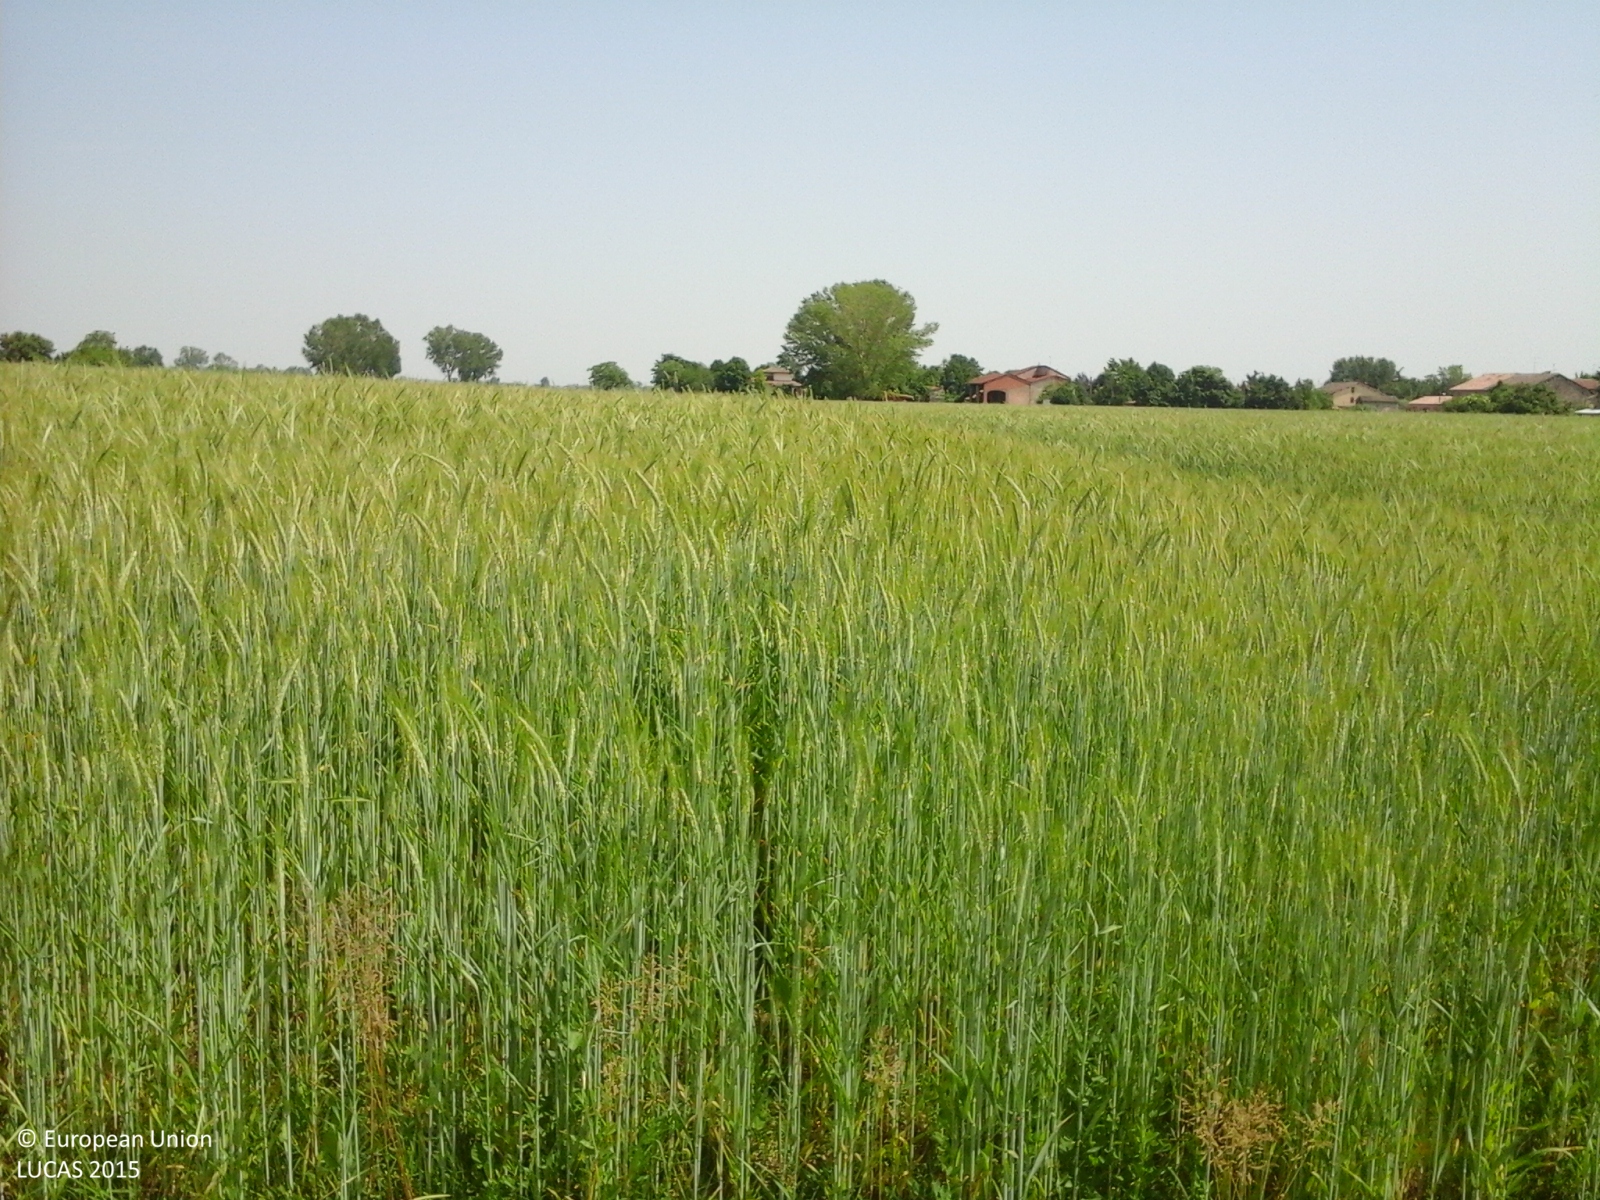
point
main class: Cropland
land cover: Common wheat
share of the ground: > 75 %
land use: Agriculture (excluding fallow land and kitchen gardens)
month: May
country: IT
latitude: 44.9453
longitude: 10.2656
